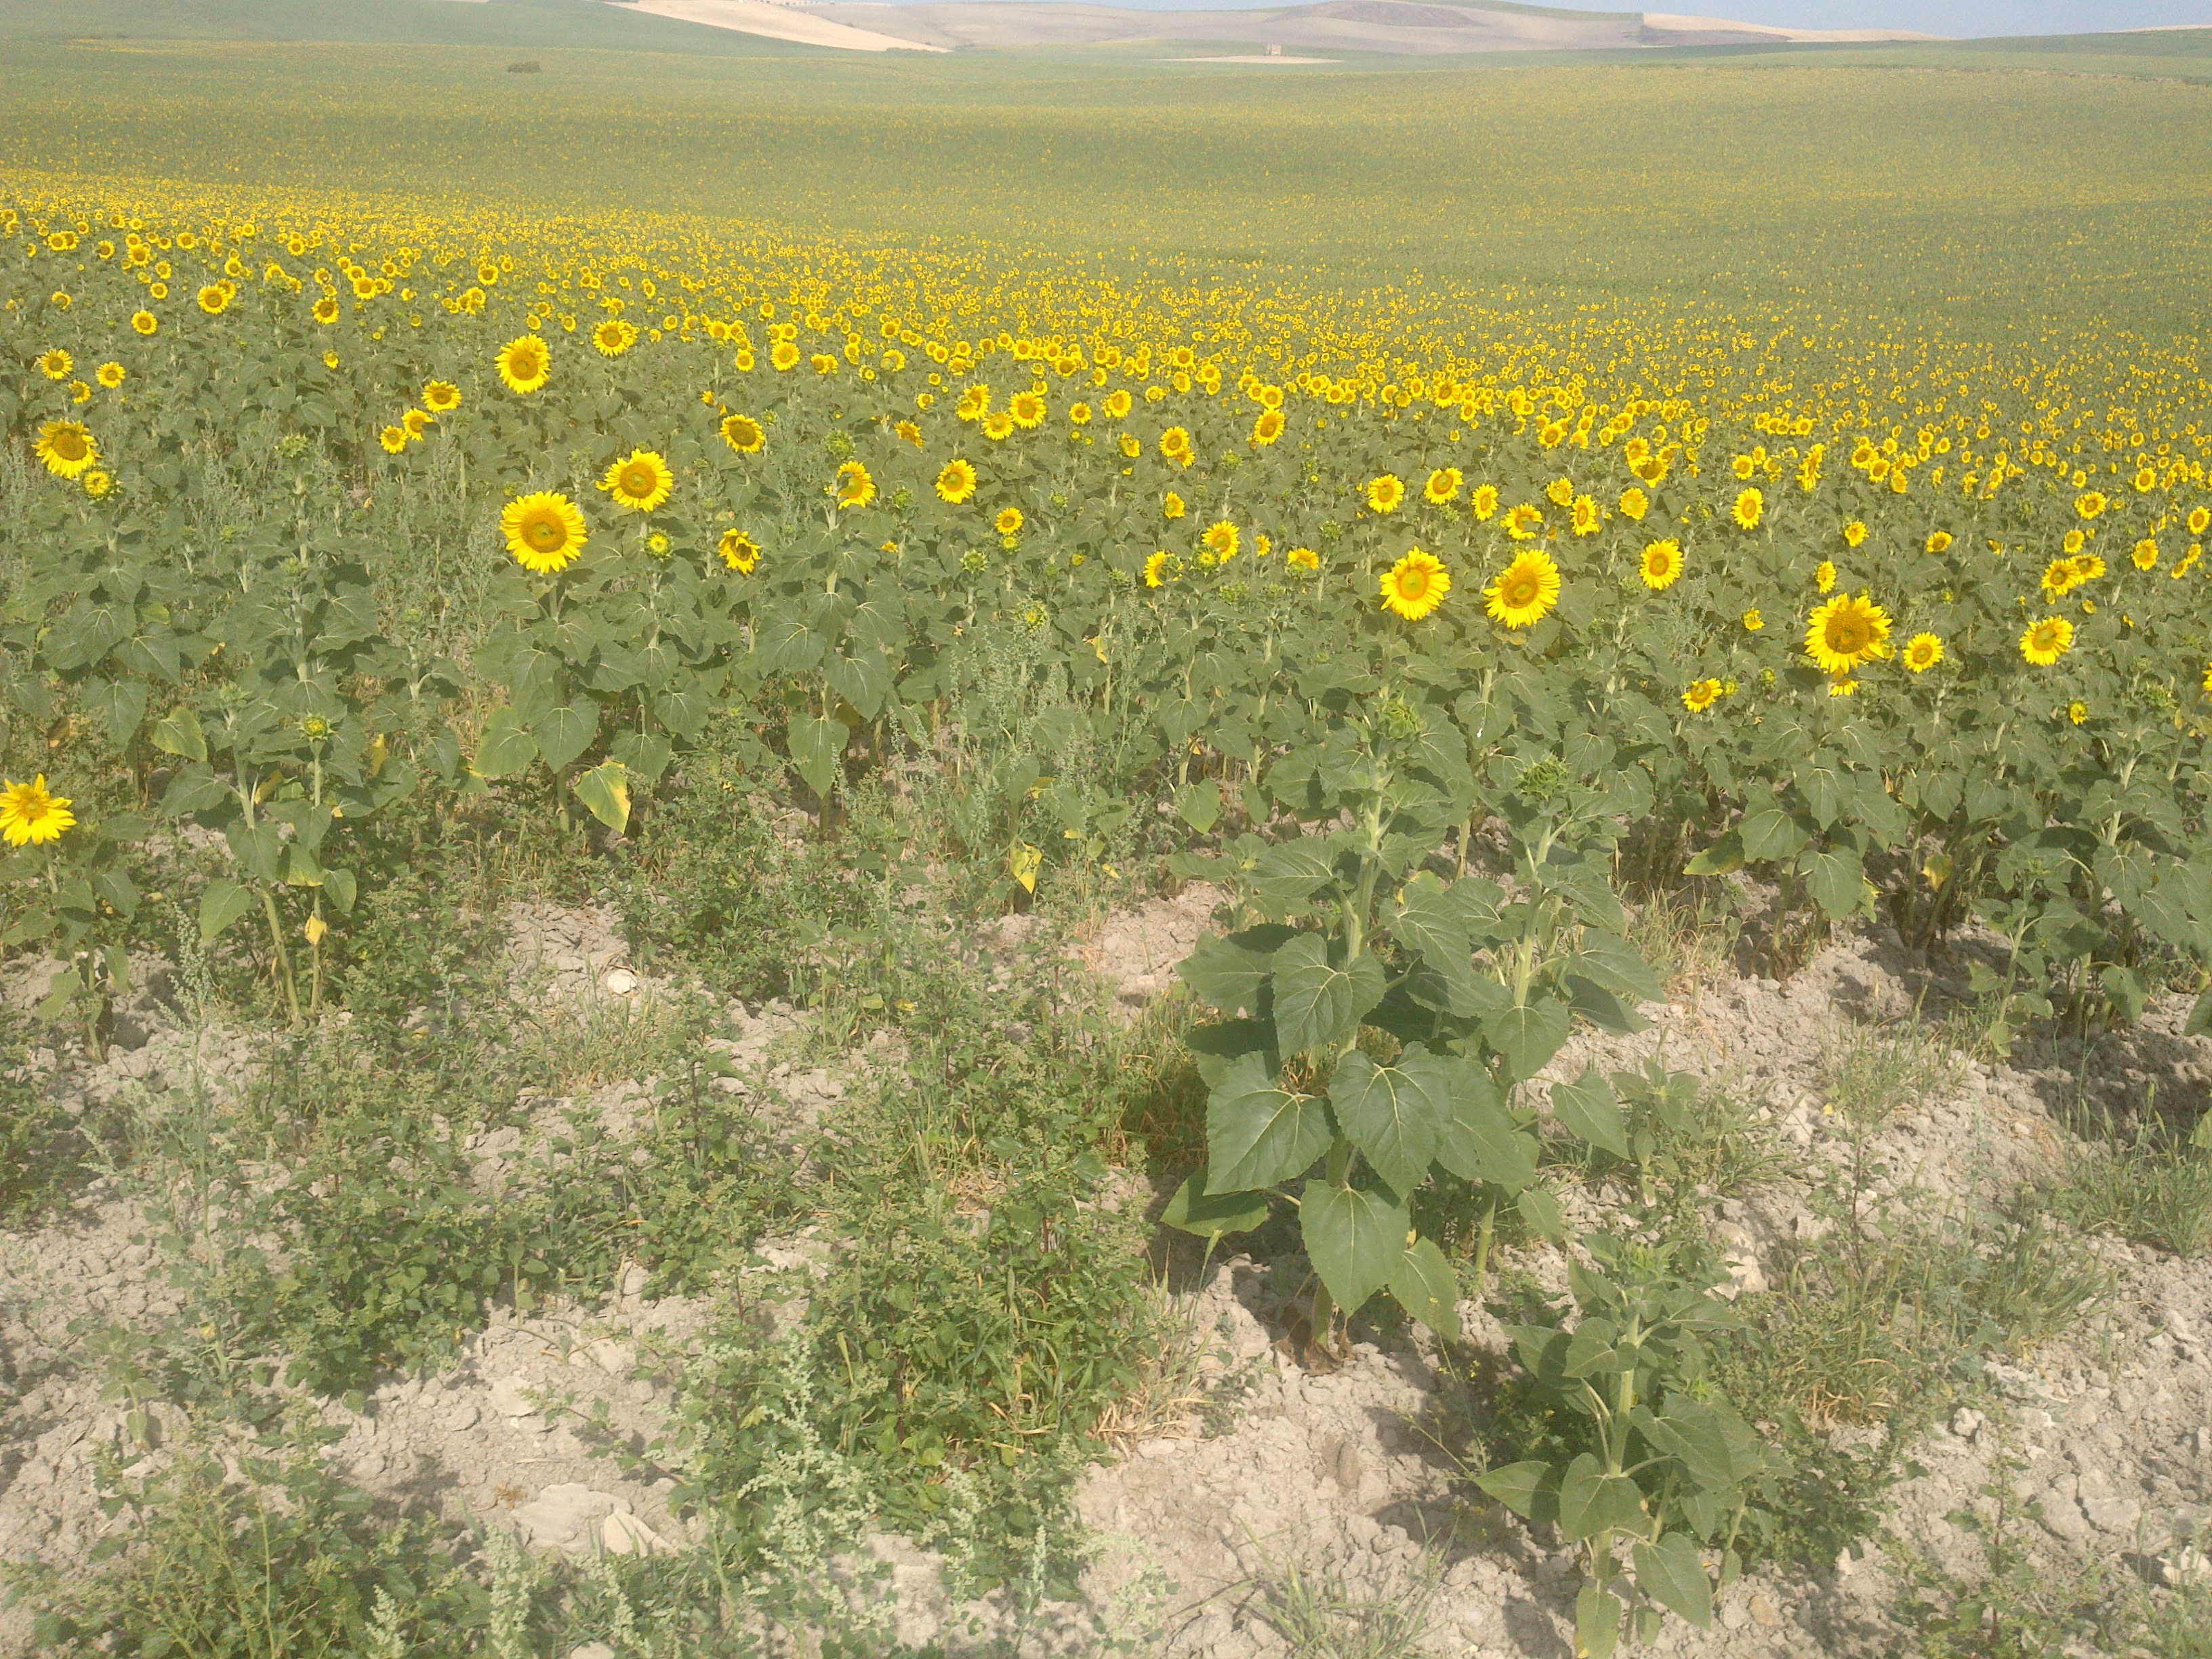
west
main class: Cropland
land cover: Sunflower
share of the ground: > 75 %
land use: Agriculture (excluding fallow land and kitchen gardens)
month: May
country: ES
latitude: 37.7763
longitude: -4.5765
